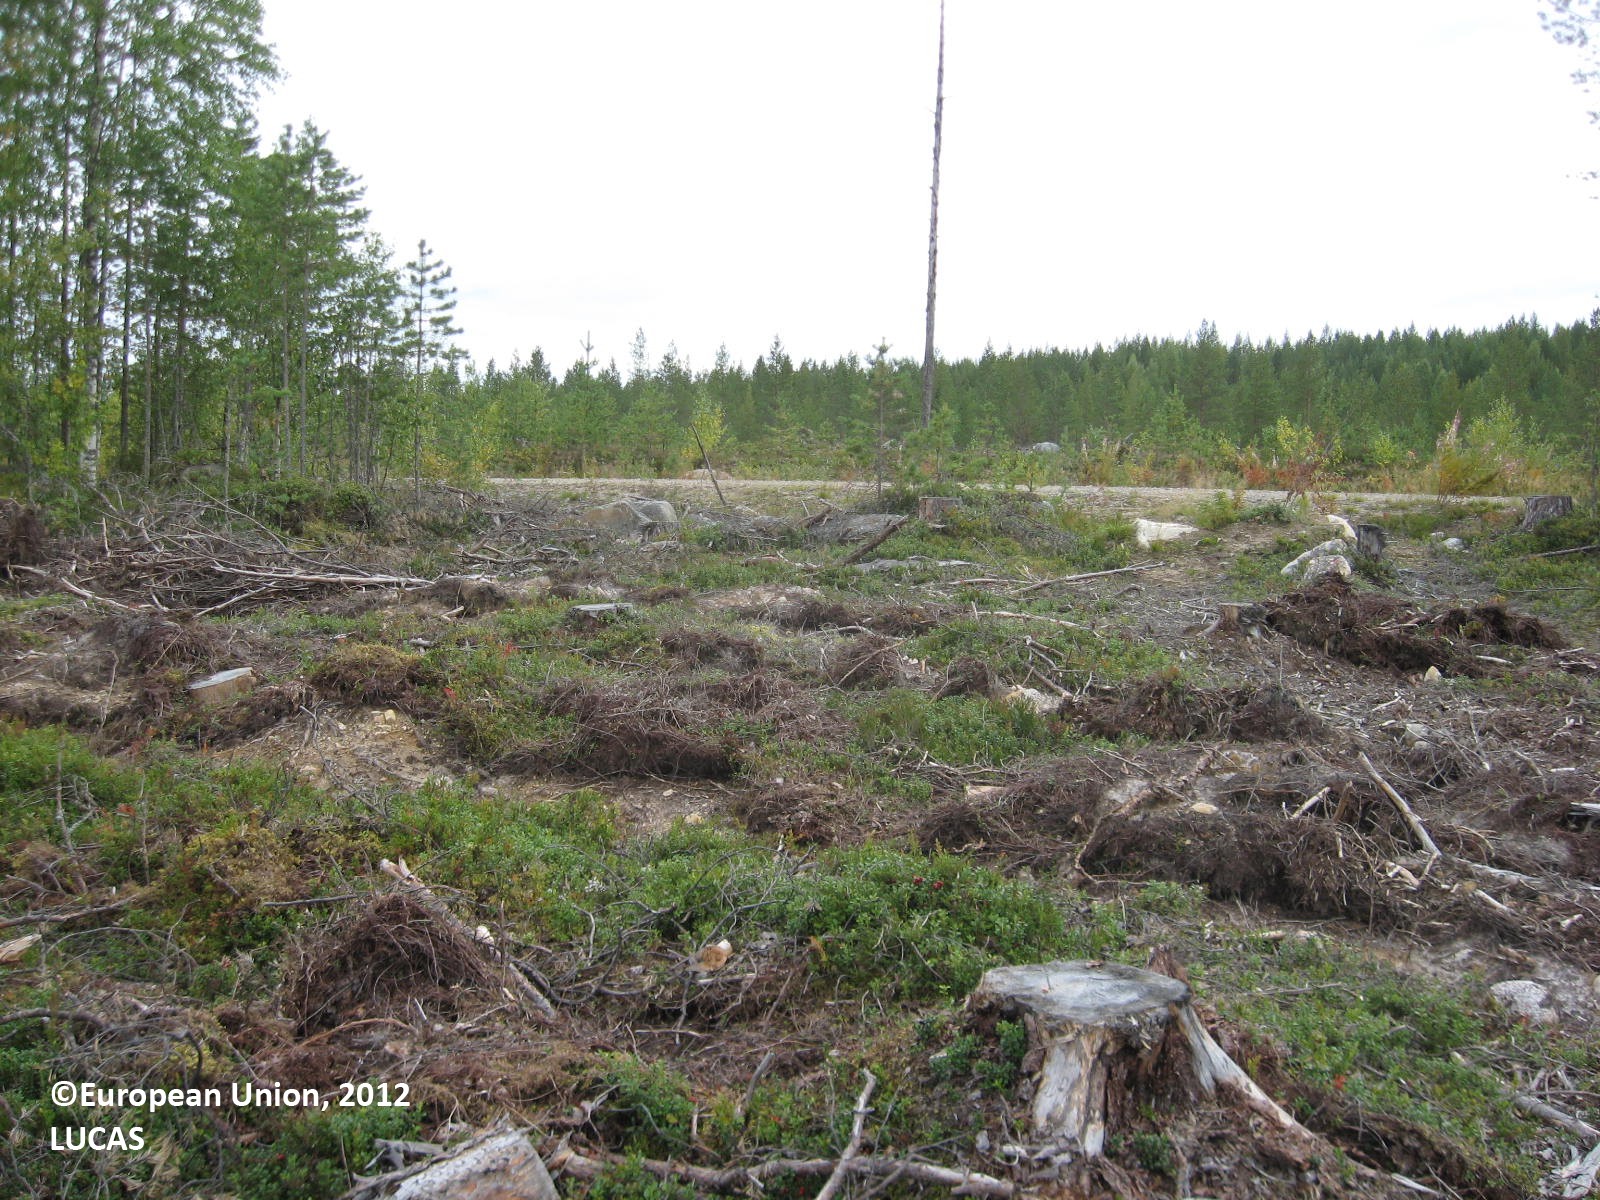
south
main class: Grassland
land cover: Grassland without tree/shrub cover
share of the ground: > 75 %
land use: Forestry
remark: Clear cut
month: August
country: FI
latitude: 63.9707
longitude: 29.2252
